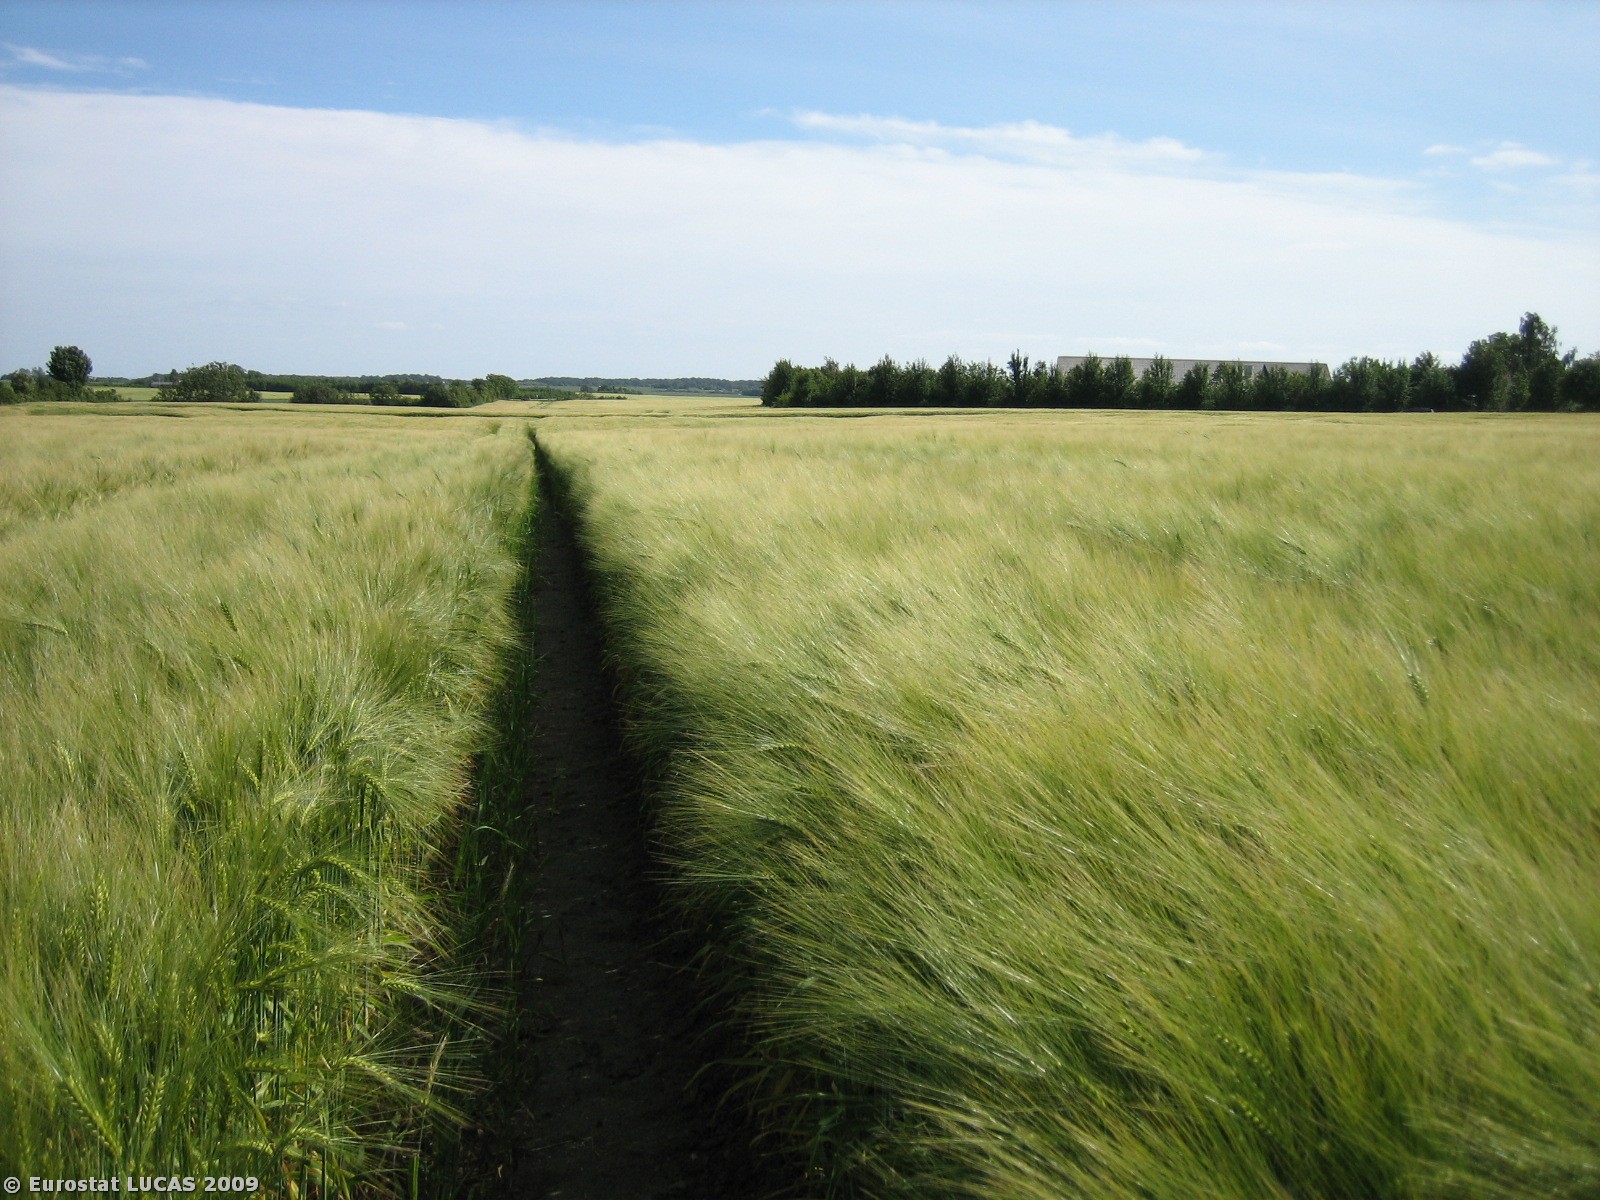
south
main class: Cropland
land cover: Barley
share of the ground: > 75 %
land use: Agriculture (excluding fallow land and kitchen gardens)
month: June
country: DK
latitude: 55.7203
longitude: 9.8569
